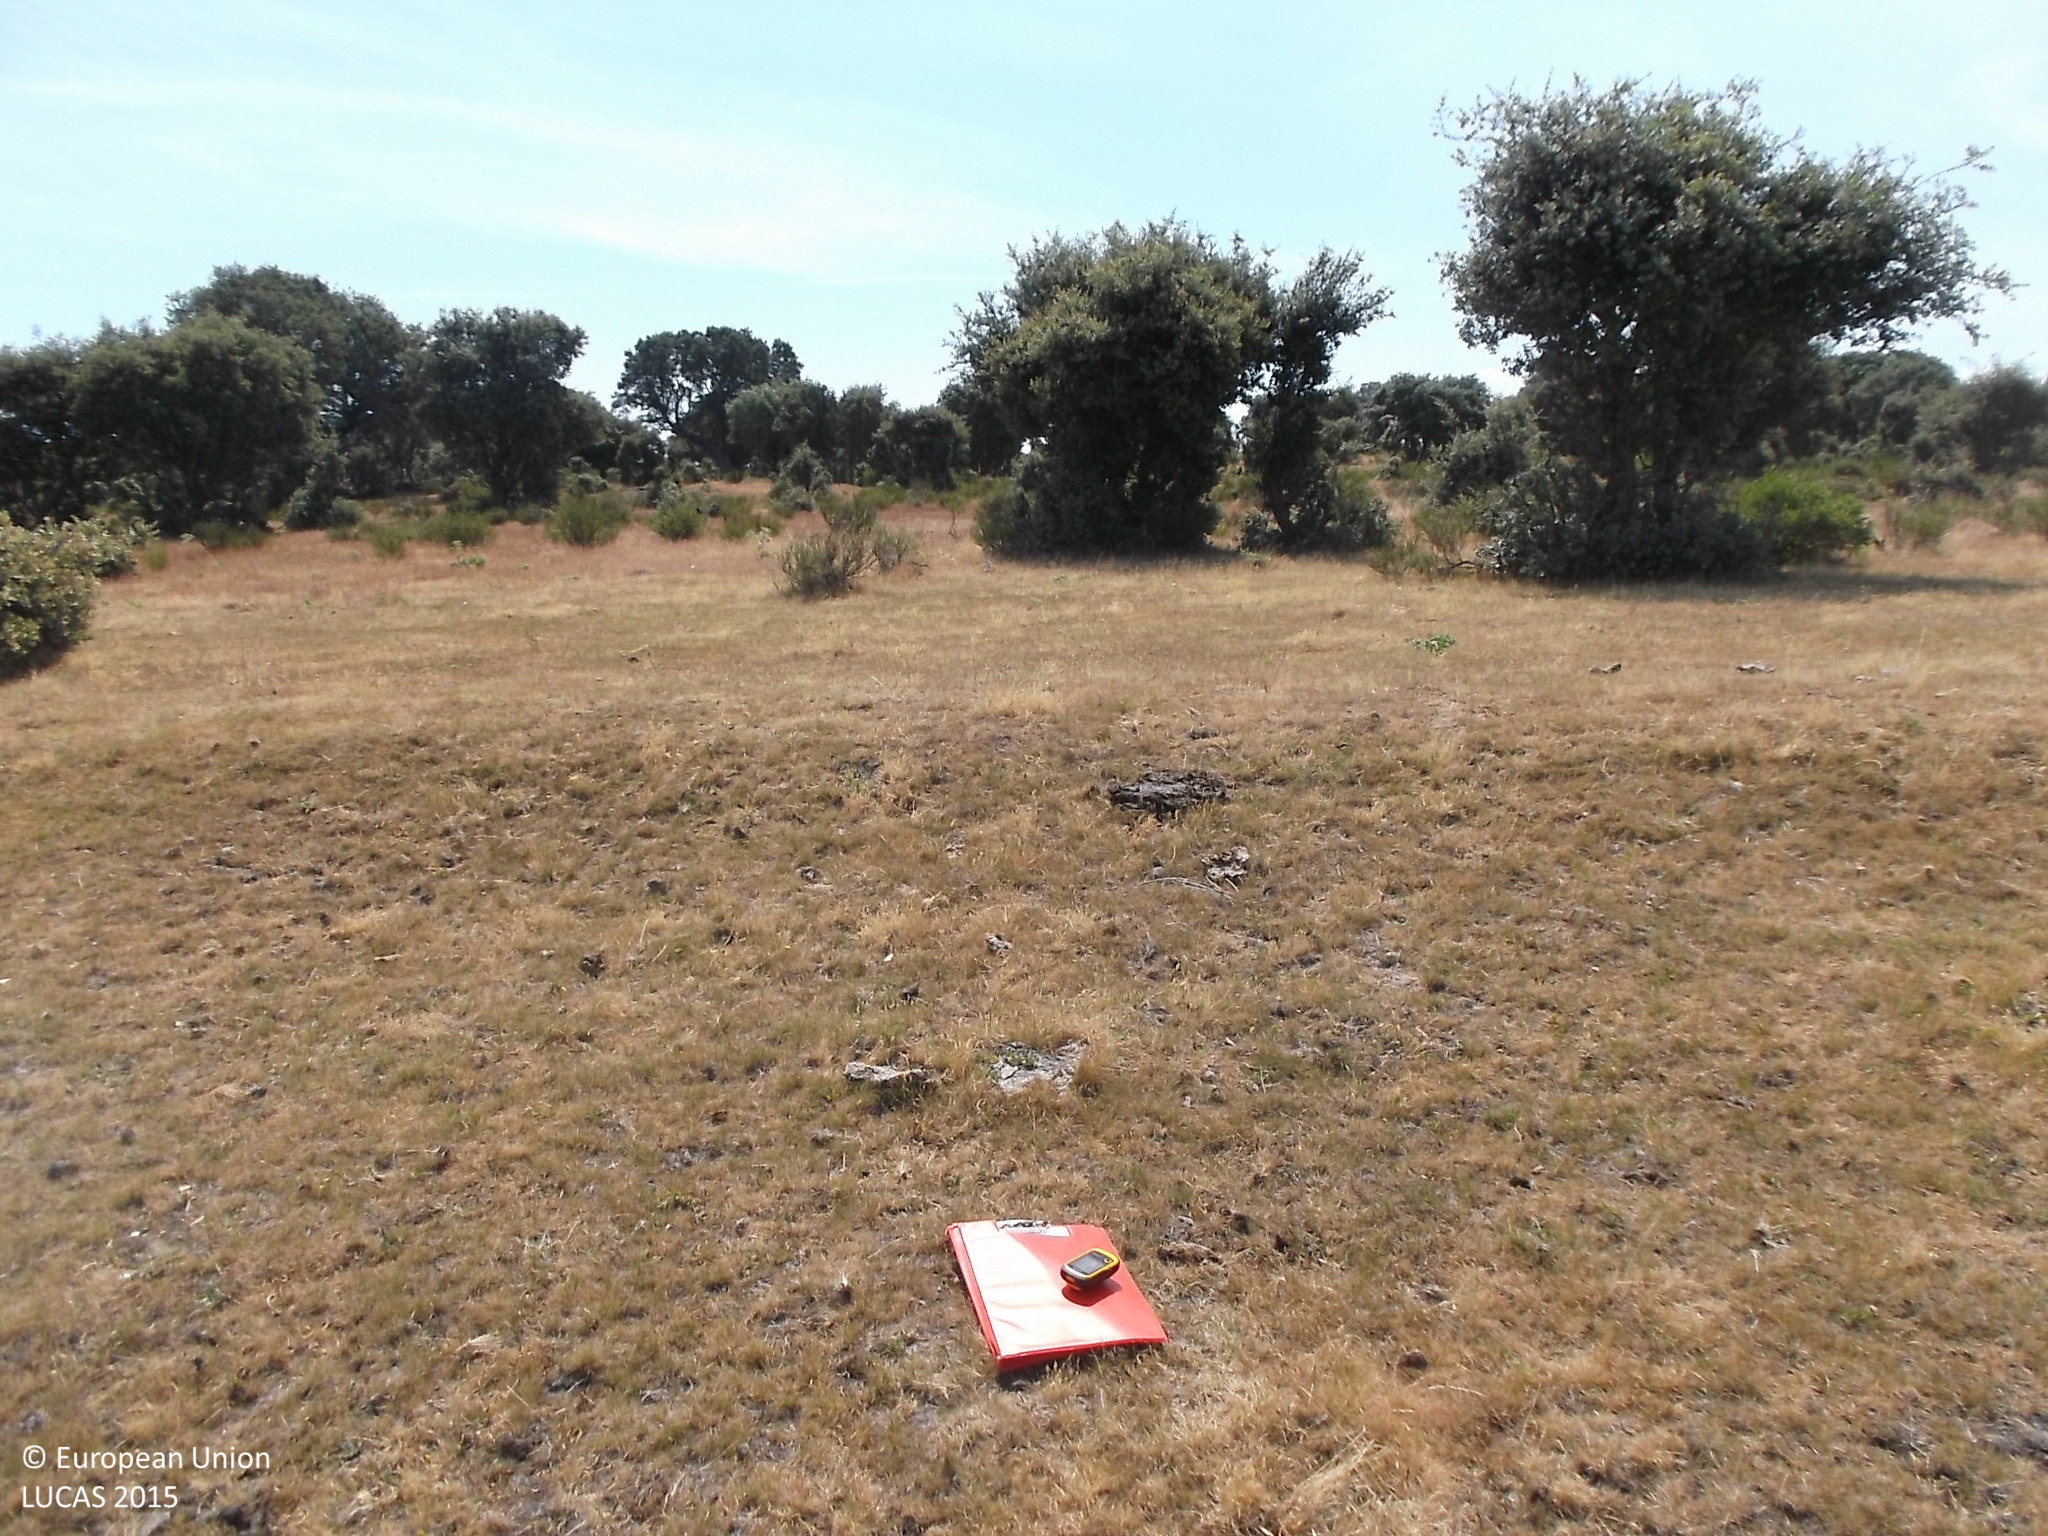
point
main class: Grassland
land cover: Grassland without tree/shrub cover
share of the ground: > 75 %
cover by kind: herbaceous plants 100 %
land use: Agriculture (excluding fallow land and kitchen gardens)
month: June
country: ES
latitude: 41.2309
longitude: -5.9663
